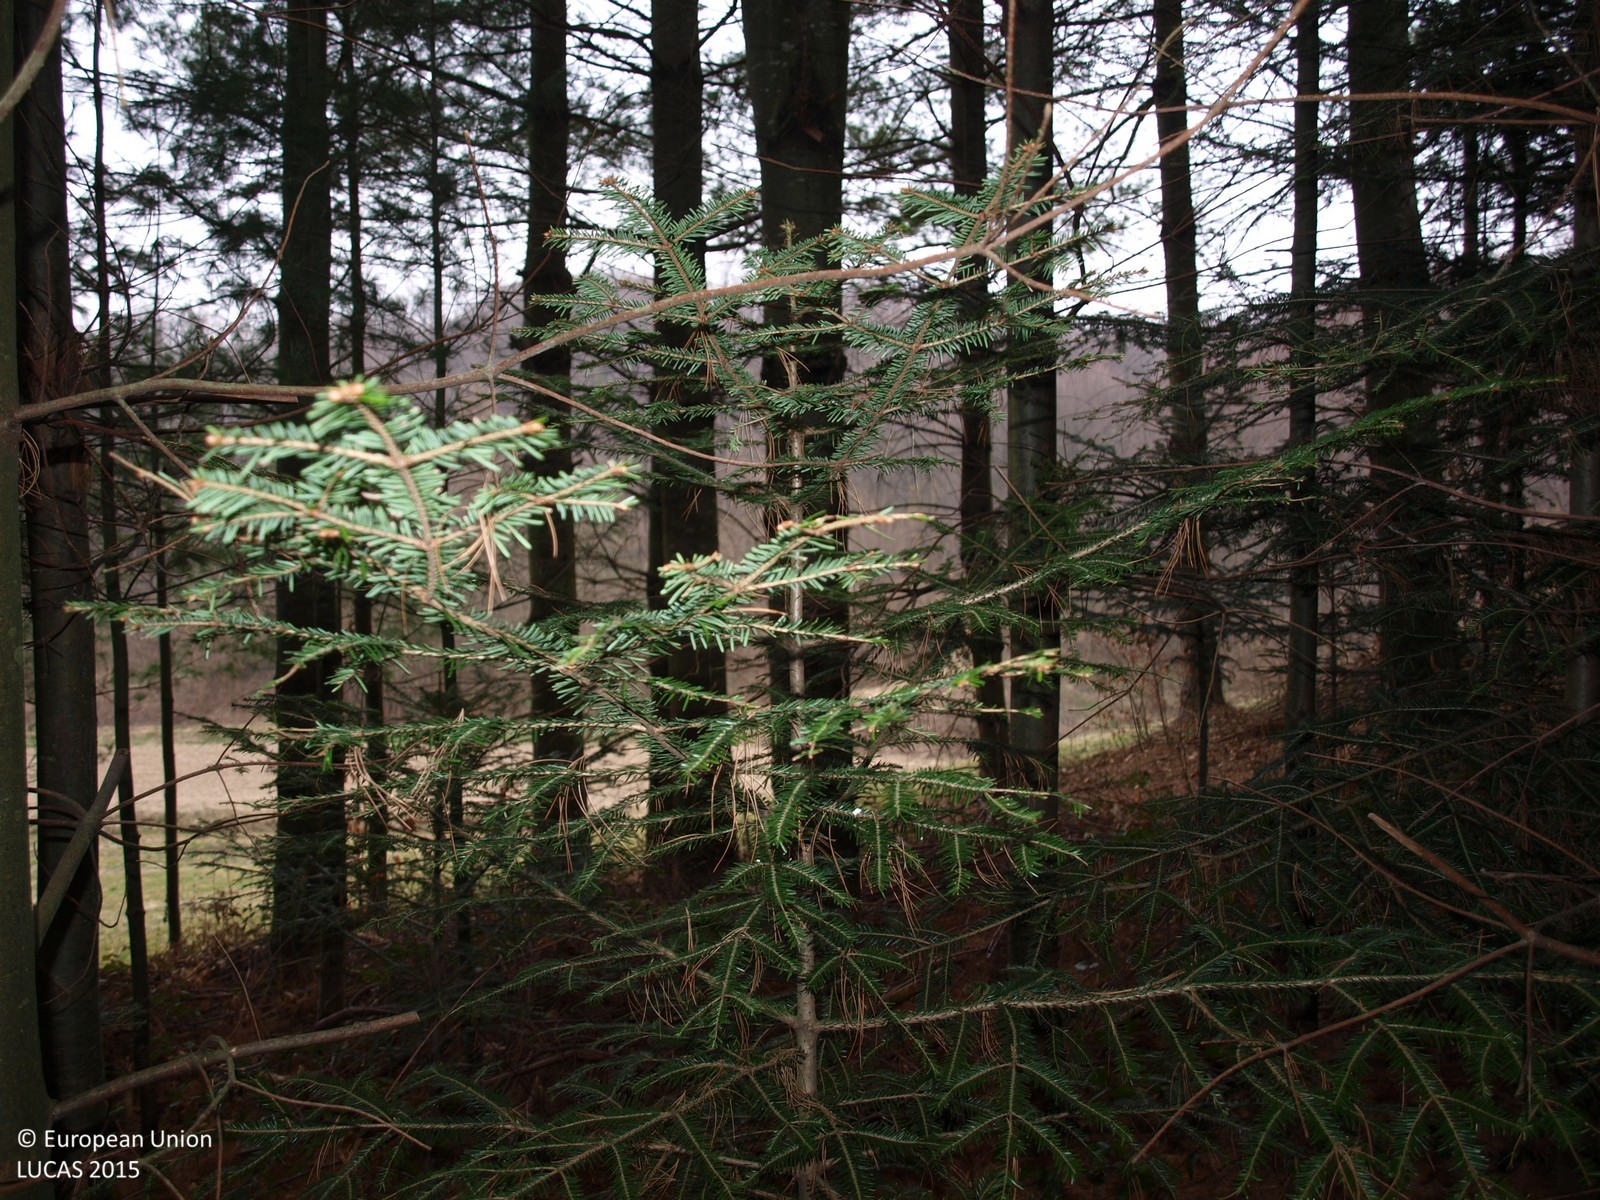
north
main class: Woodland
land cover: Spruce dominated coniferous woodland
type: hemiboreal forest and nemoral coniferous forest and mixed broadleaved-coniferous forest
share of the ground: > 75 %
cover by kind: coniferous forest trees 90 %, shrubs 5 %, herbaceous plants 5 %
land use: Forestry
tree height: > 5 m
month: March
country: HR
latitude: 46.2070
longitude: 16.2078
